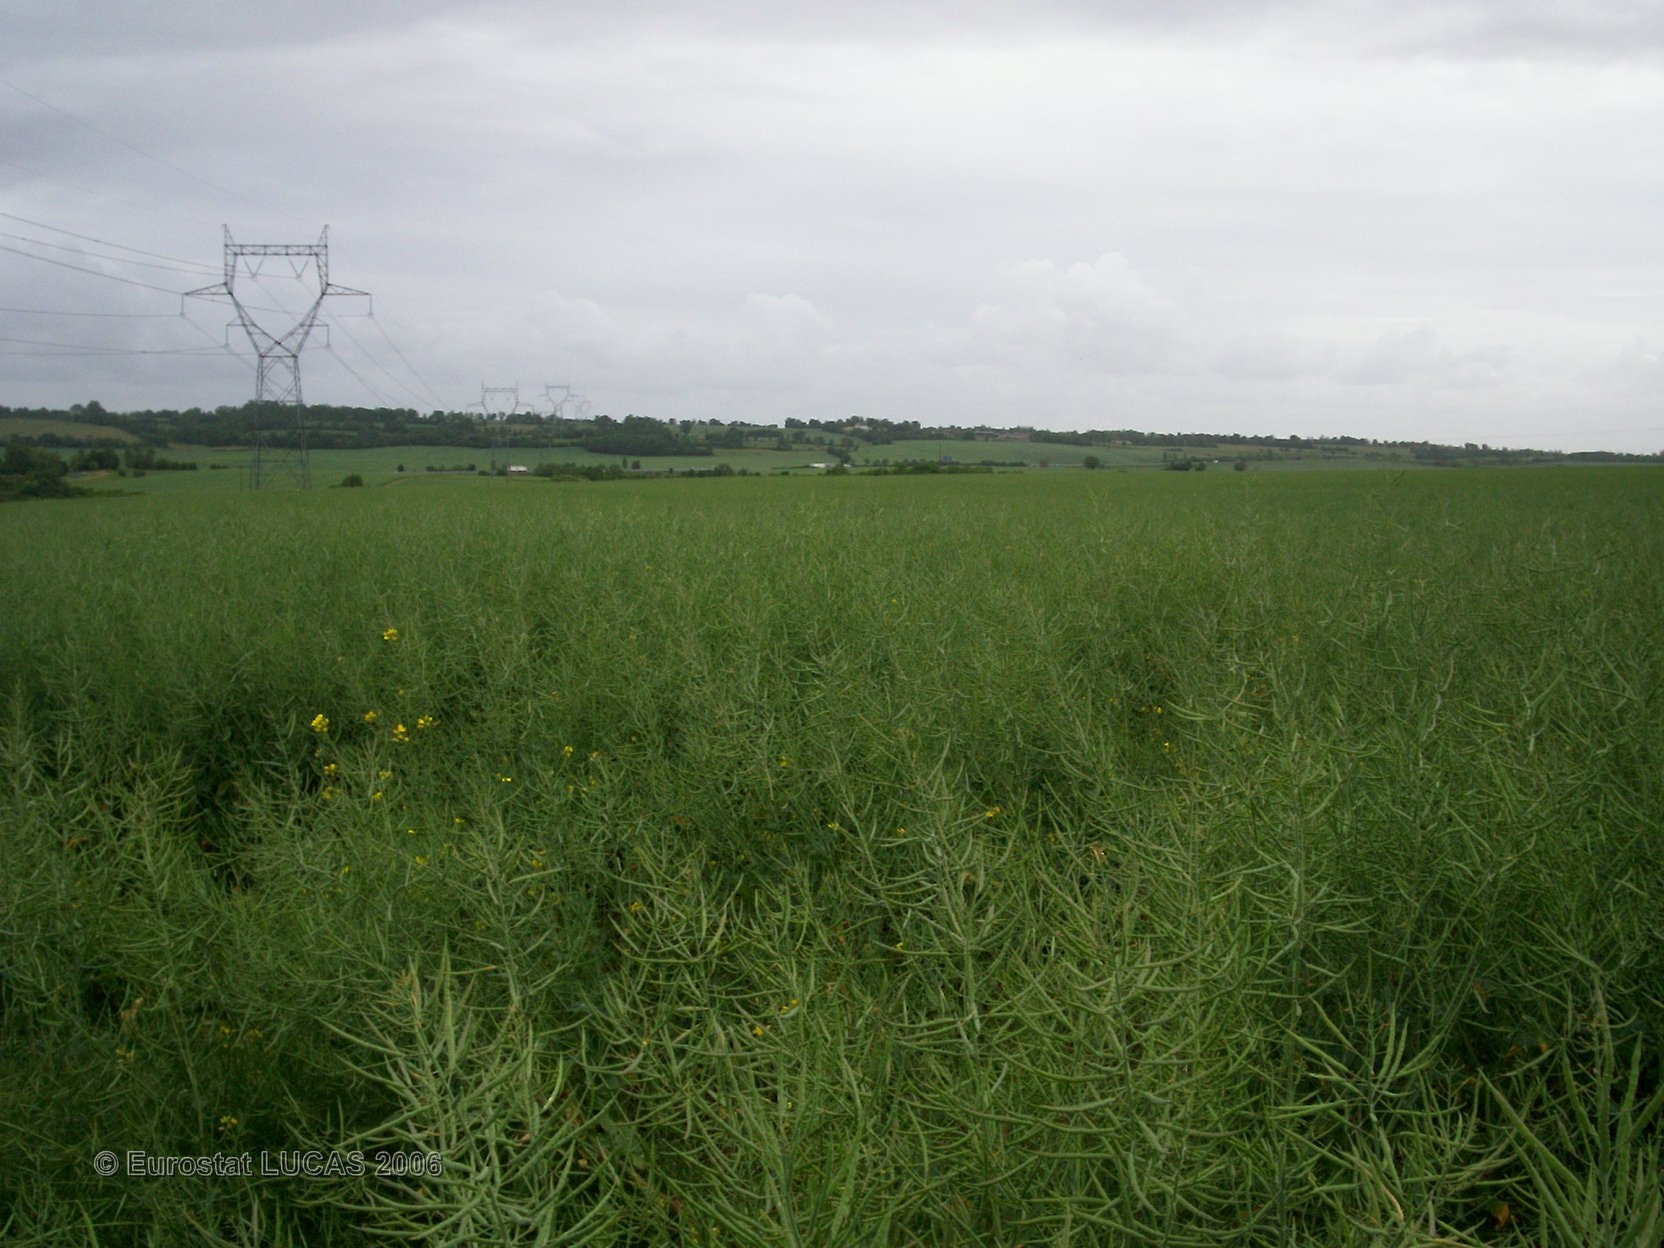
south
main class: Cropland
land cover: Rape and turnip rape
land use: Agriculture (excluding fallow land and kitchen gardens)
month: May
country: FR
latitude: 46.3629
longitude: -0.2788
